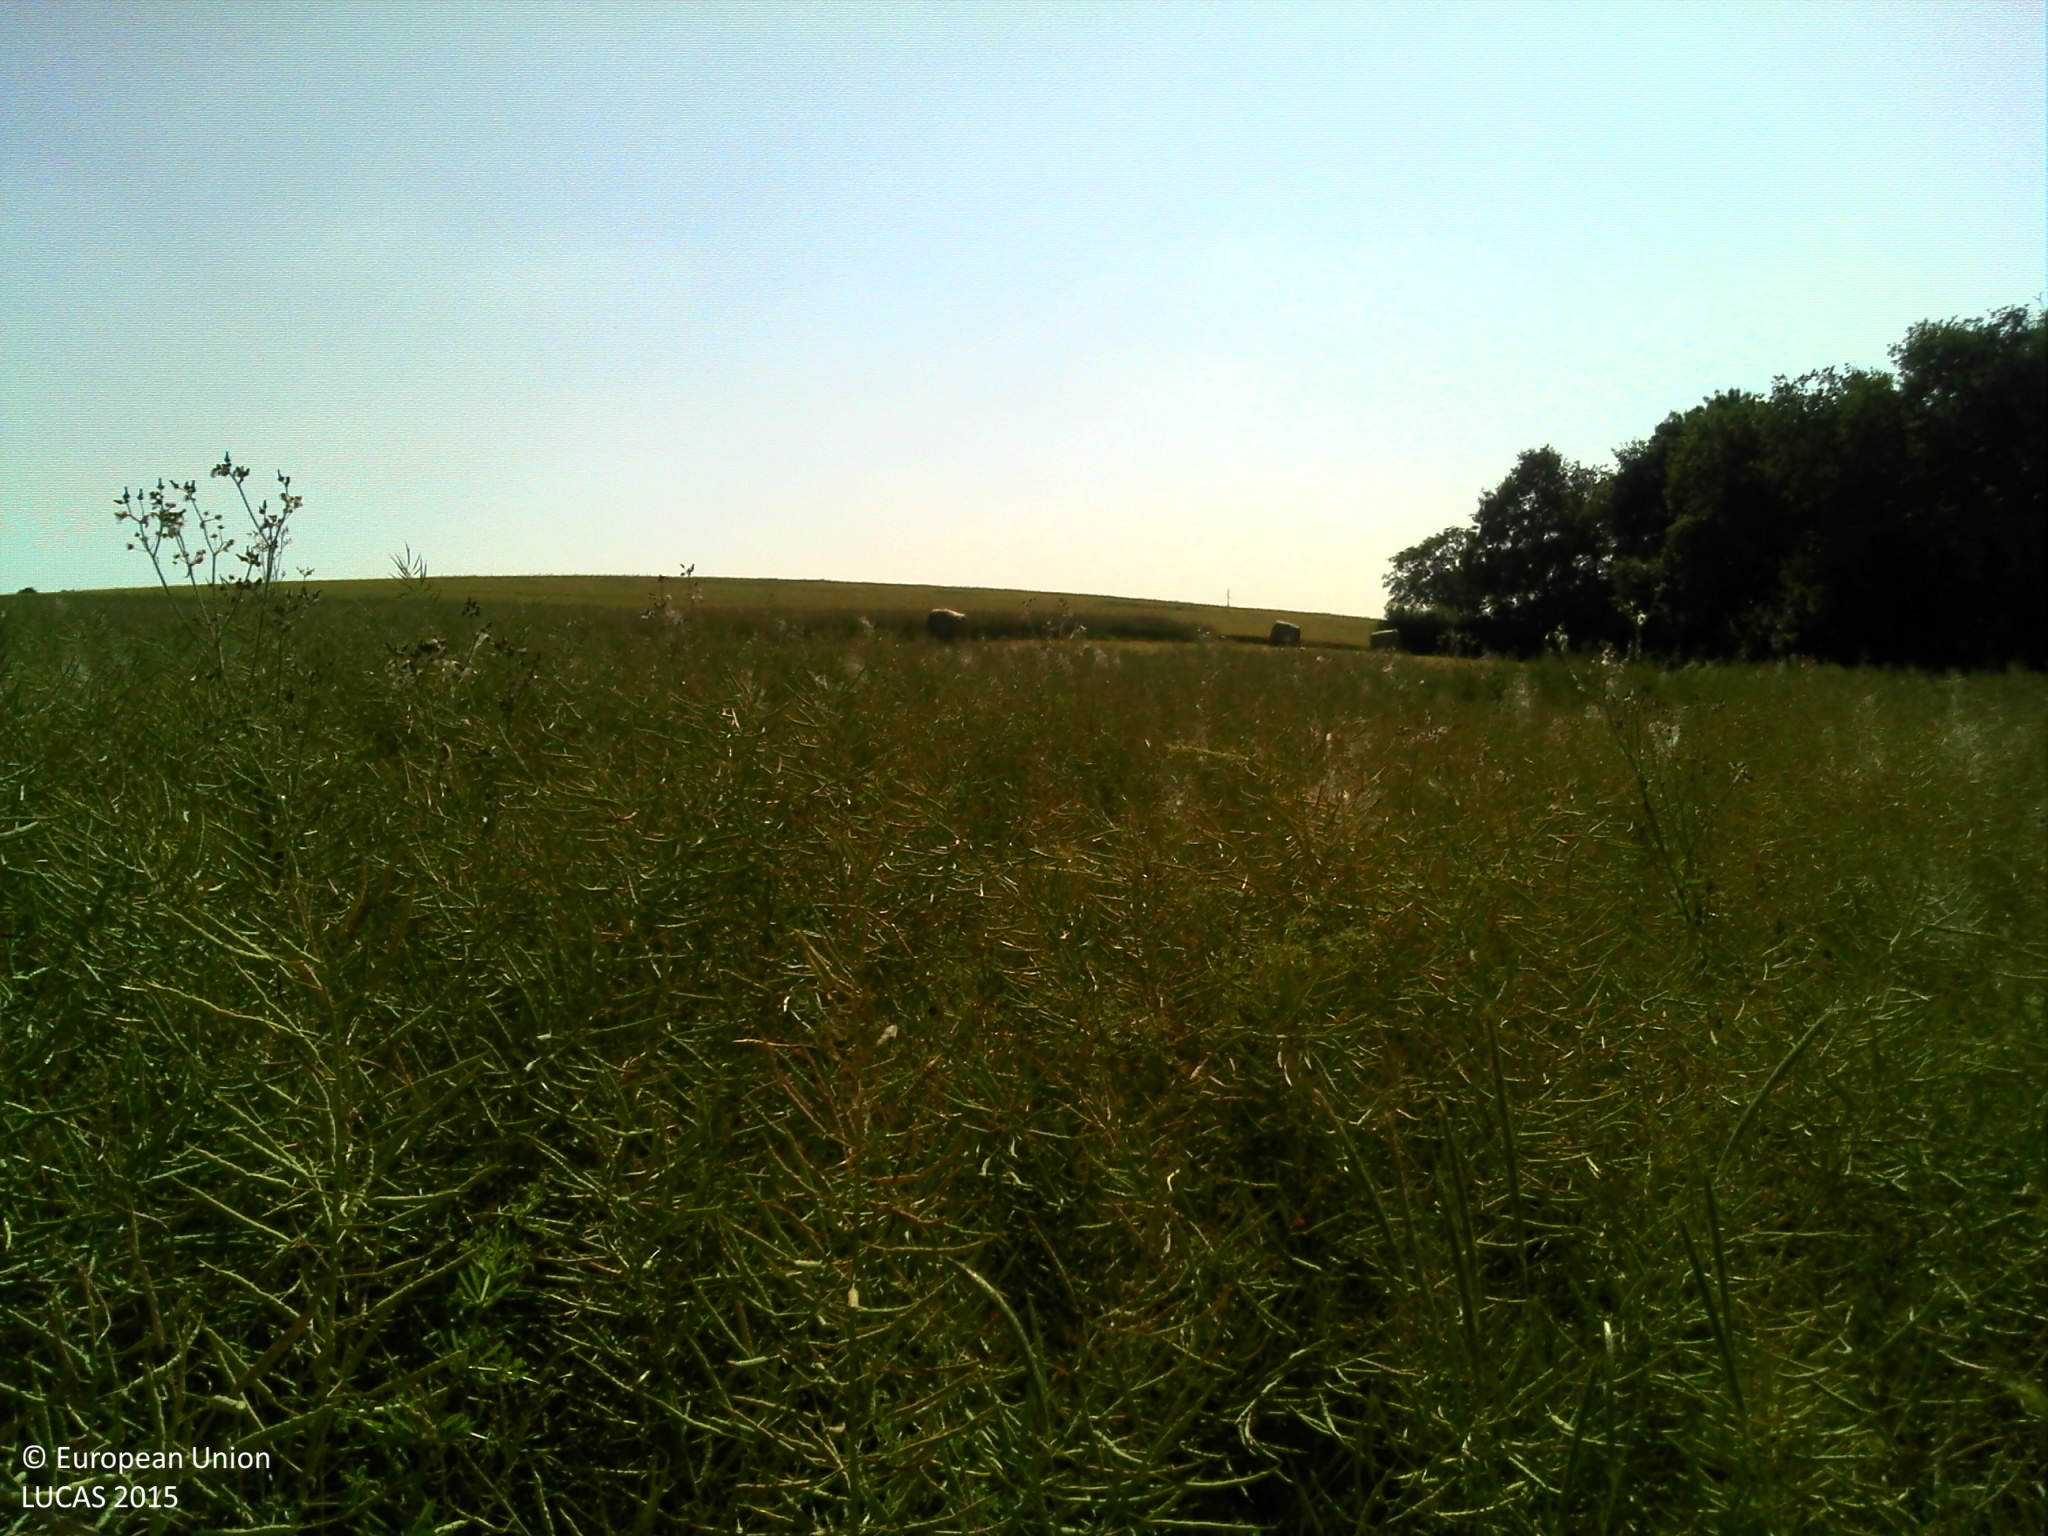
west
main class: Cropland
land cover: Rape and turnip rape
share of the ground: > 75 %
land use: Agriculture (excluding fallow land and kitchen gardens)
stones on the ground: < 10 %
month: June
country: FR
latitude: 43.6832
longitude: 0.7568
